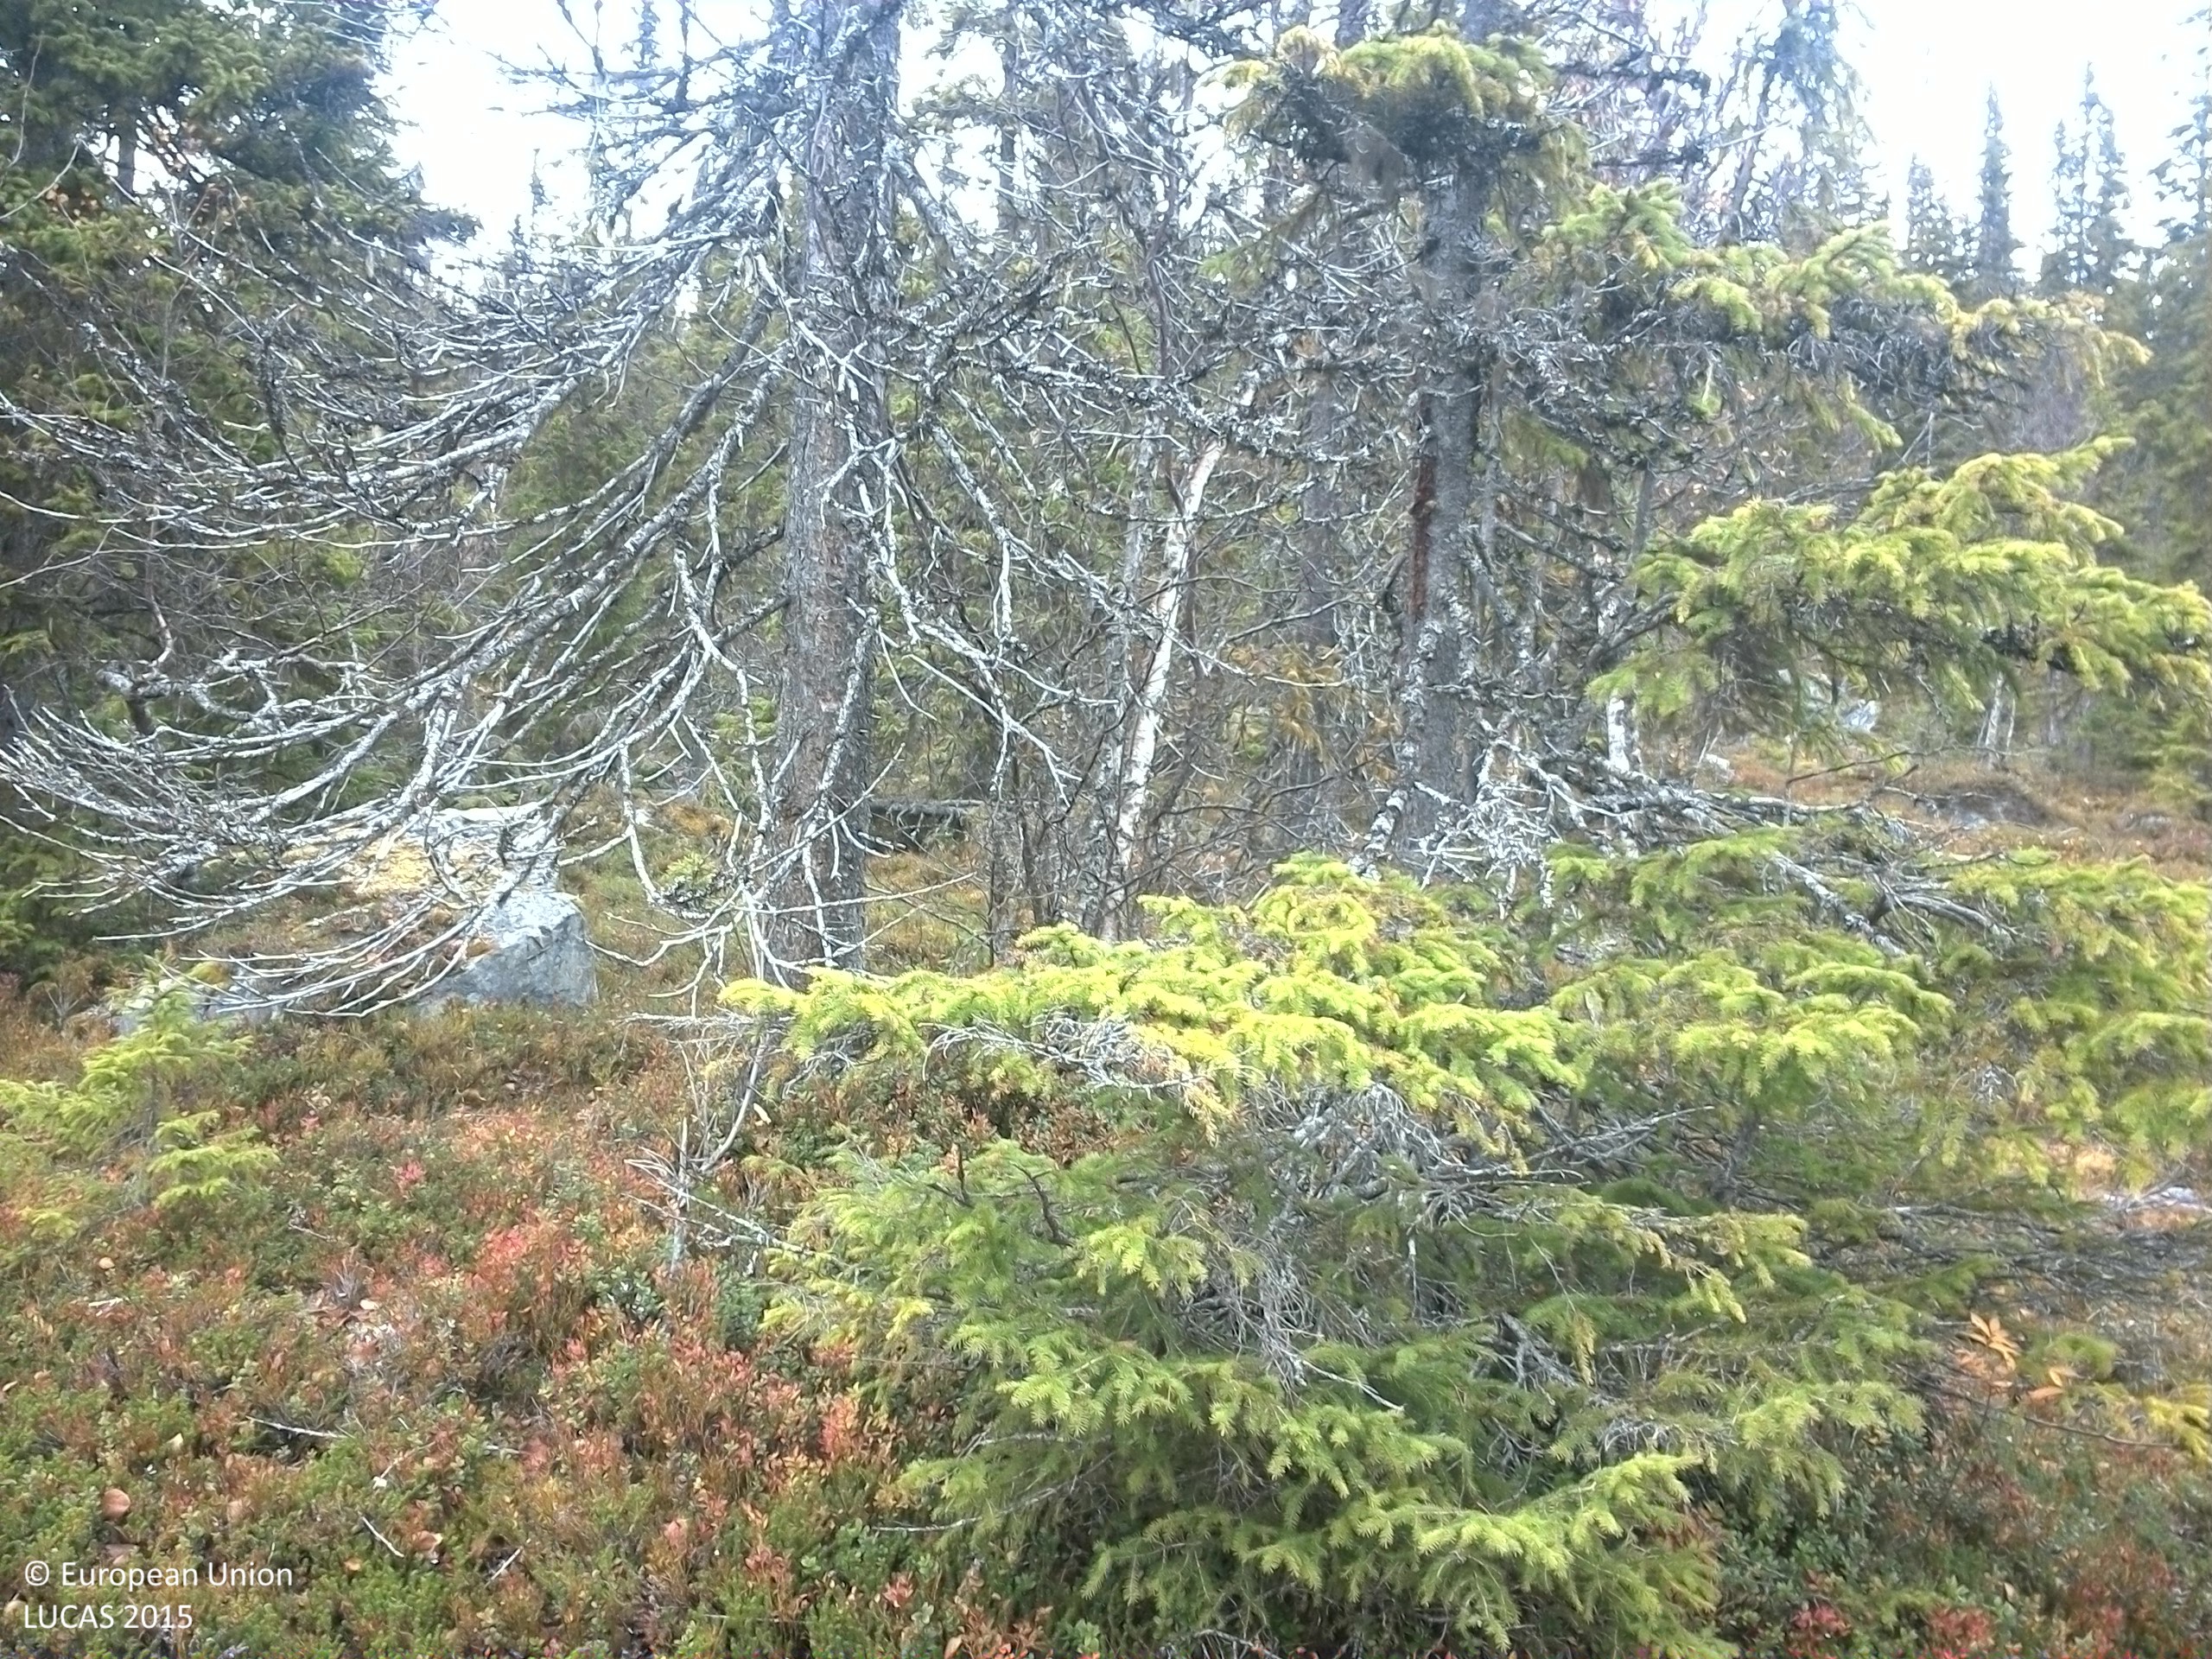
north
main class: Woodland
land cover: Pine dominated mixed woodland
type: boreal forest
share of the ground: 25 - 50 %
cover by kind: broadleaved forest trees 30 %, shrubs 30 %, coniferous forest trees 15 %, lichens and mosses 15 %, consolidated bare surface 10 %
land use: Forestry
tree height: < 5 m
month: October
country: SE
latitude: 64.4337
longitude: 14.8117
